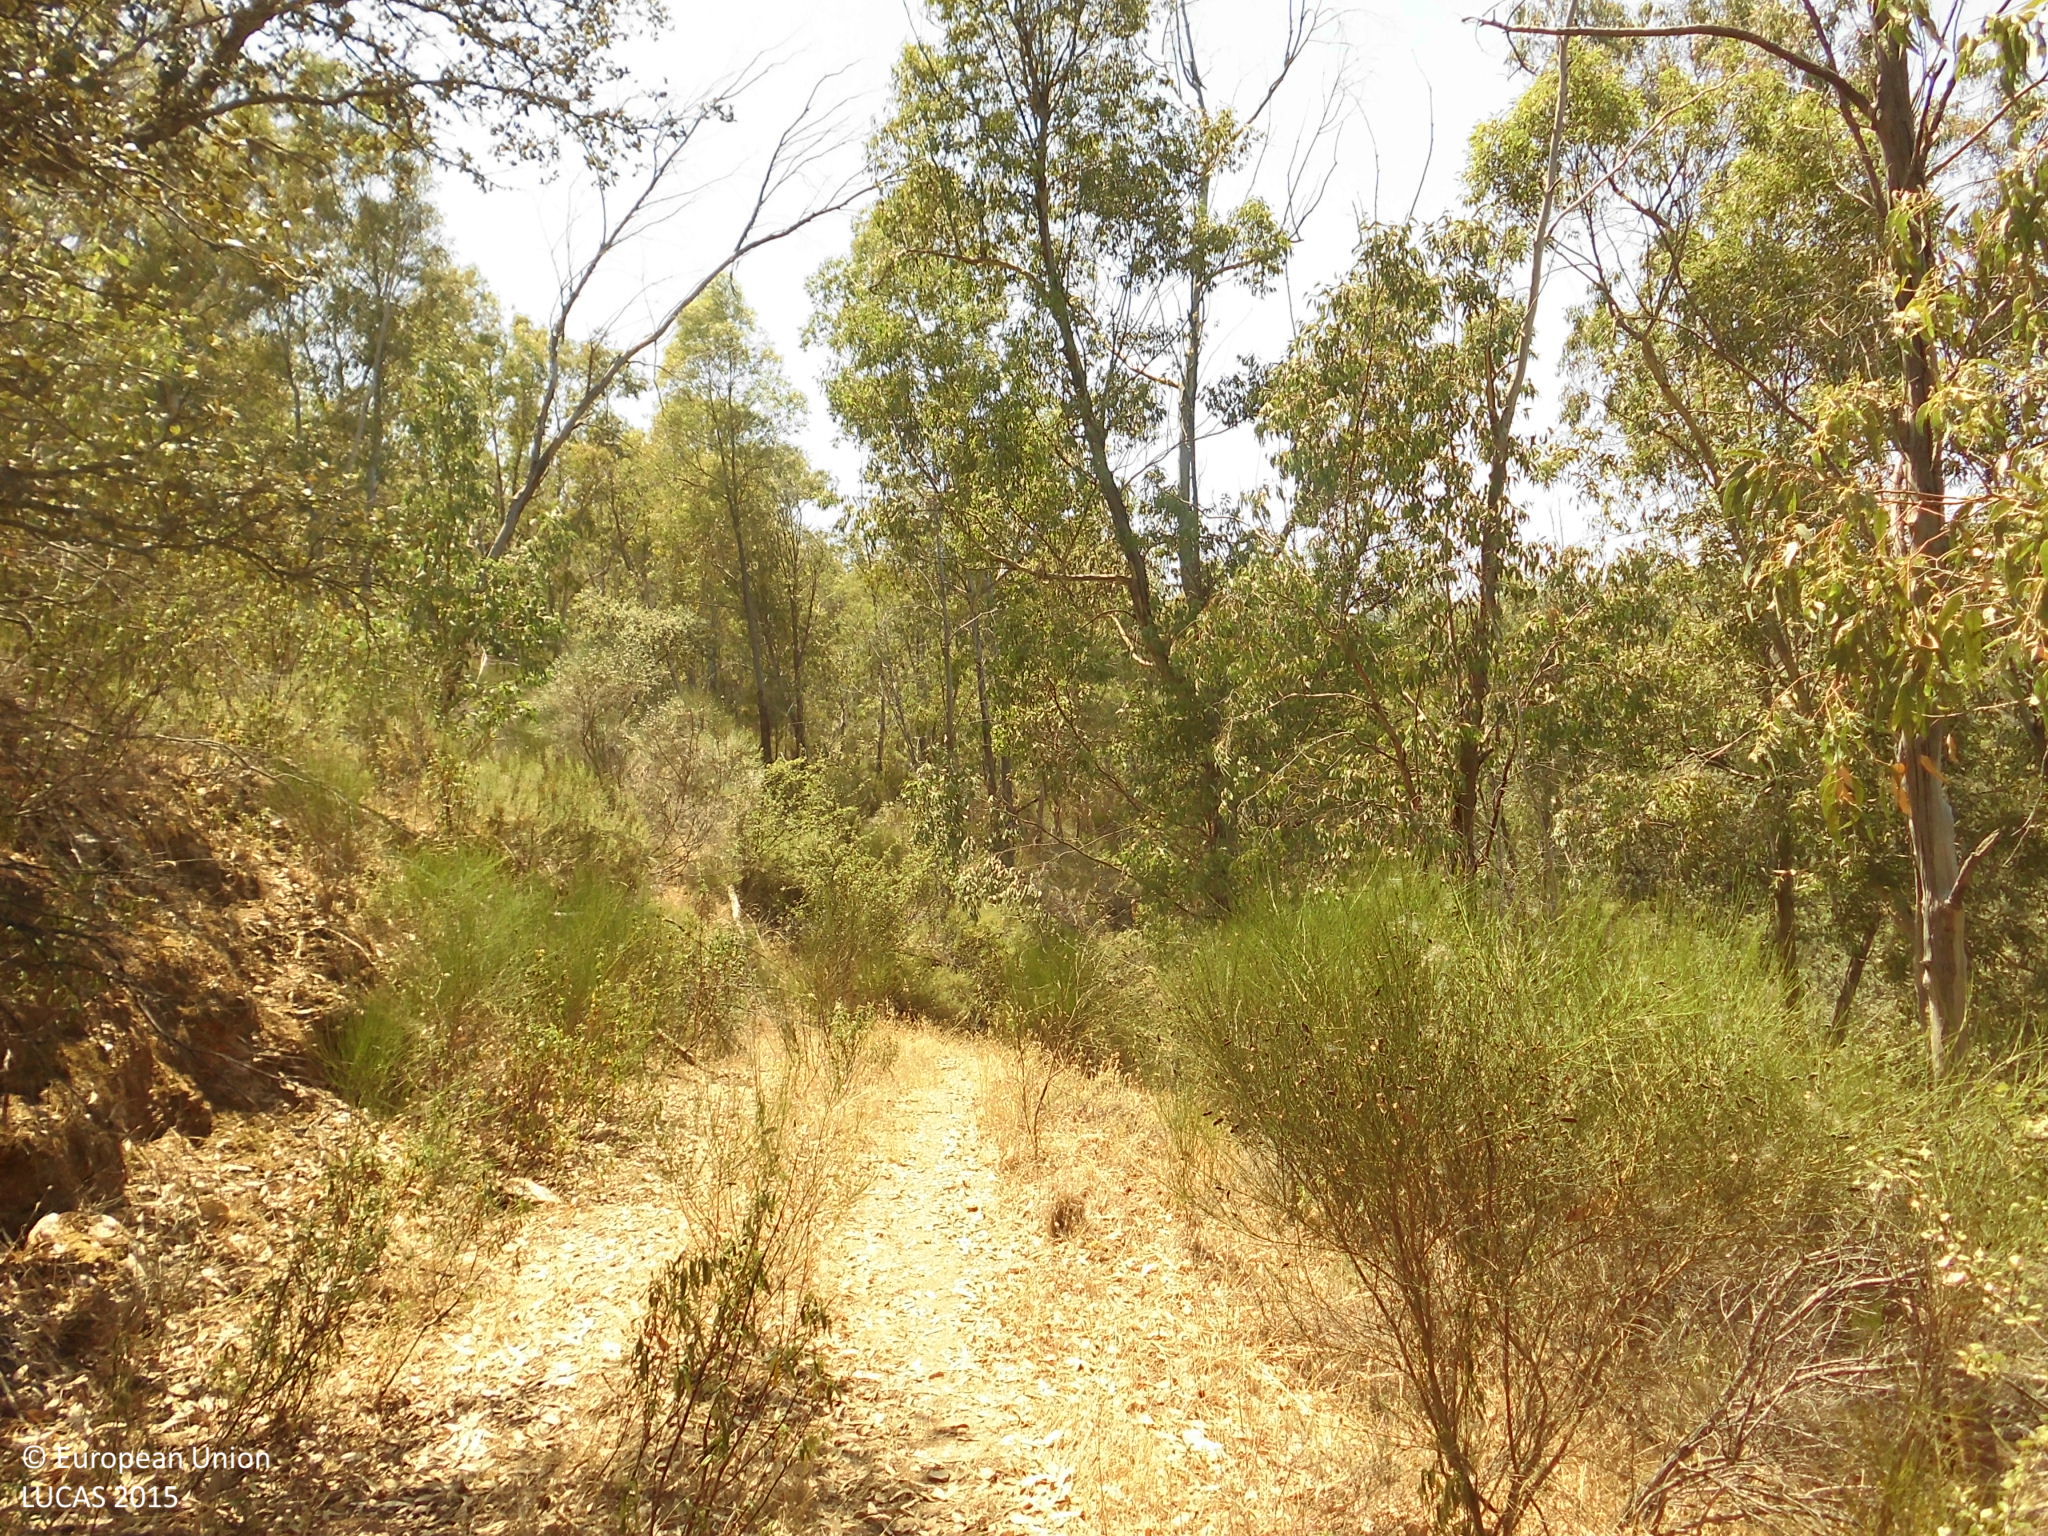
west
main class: Woodland
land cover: Broadleaved woodland
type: exotic forest
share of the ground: 50 - 75 %
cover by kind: broadleaved forest trees 75 %, shrubs 20 %, herbaceous plants 5 %
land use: Forestry
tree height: > 5 m
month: July
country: ES
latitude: 39.7205
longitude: -5.4179
